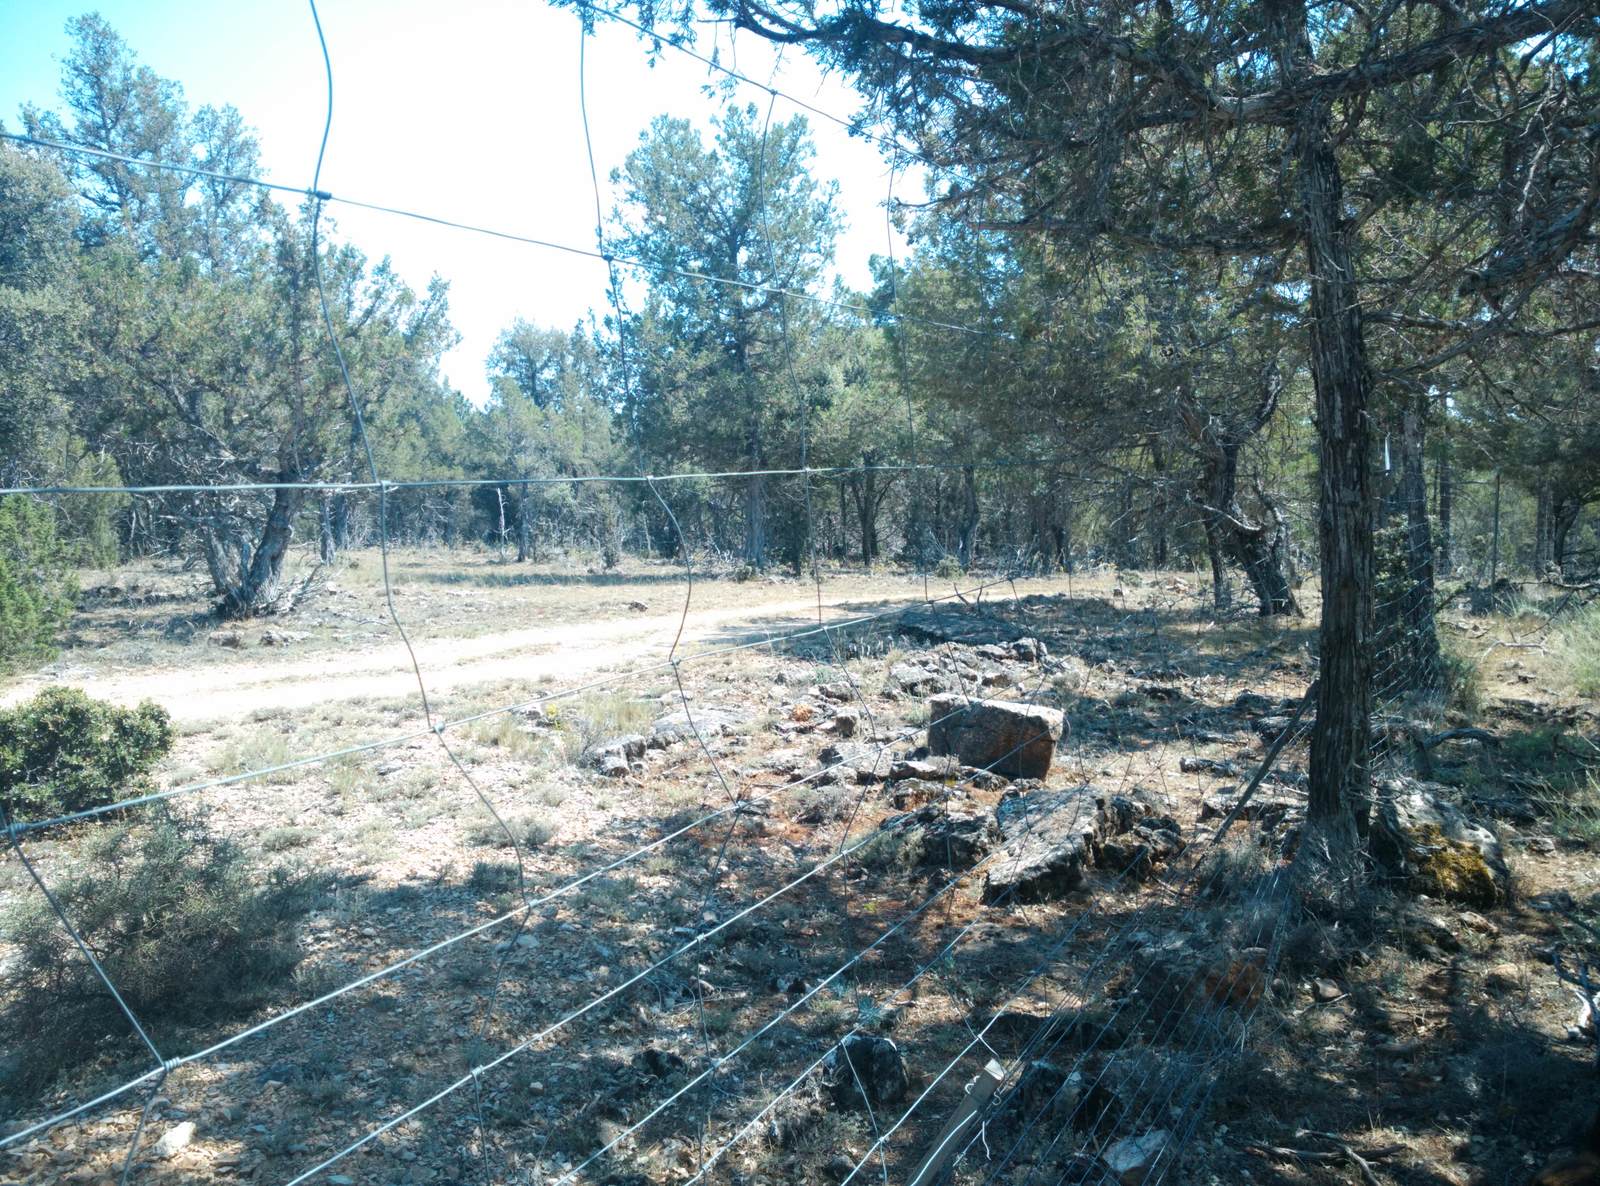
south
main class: Woodland
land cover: Pine dominated coniferous woodland
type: coniferous forest of the mediterranean region
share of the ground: 50 - 75 %
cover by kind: coniferous forest trees 50 %, unconsolidated bare surface 35 %, shrubs 10 %, broadleaved forest trees 5 %
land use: Semi-natural and natural areas not in use
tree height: > 5 m
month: July
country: ES
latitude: 40.8476
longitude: -2.1109
